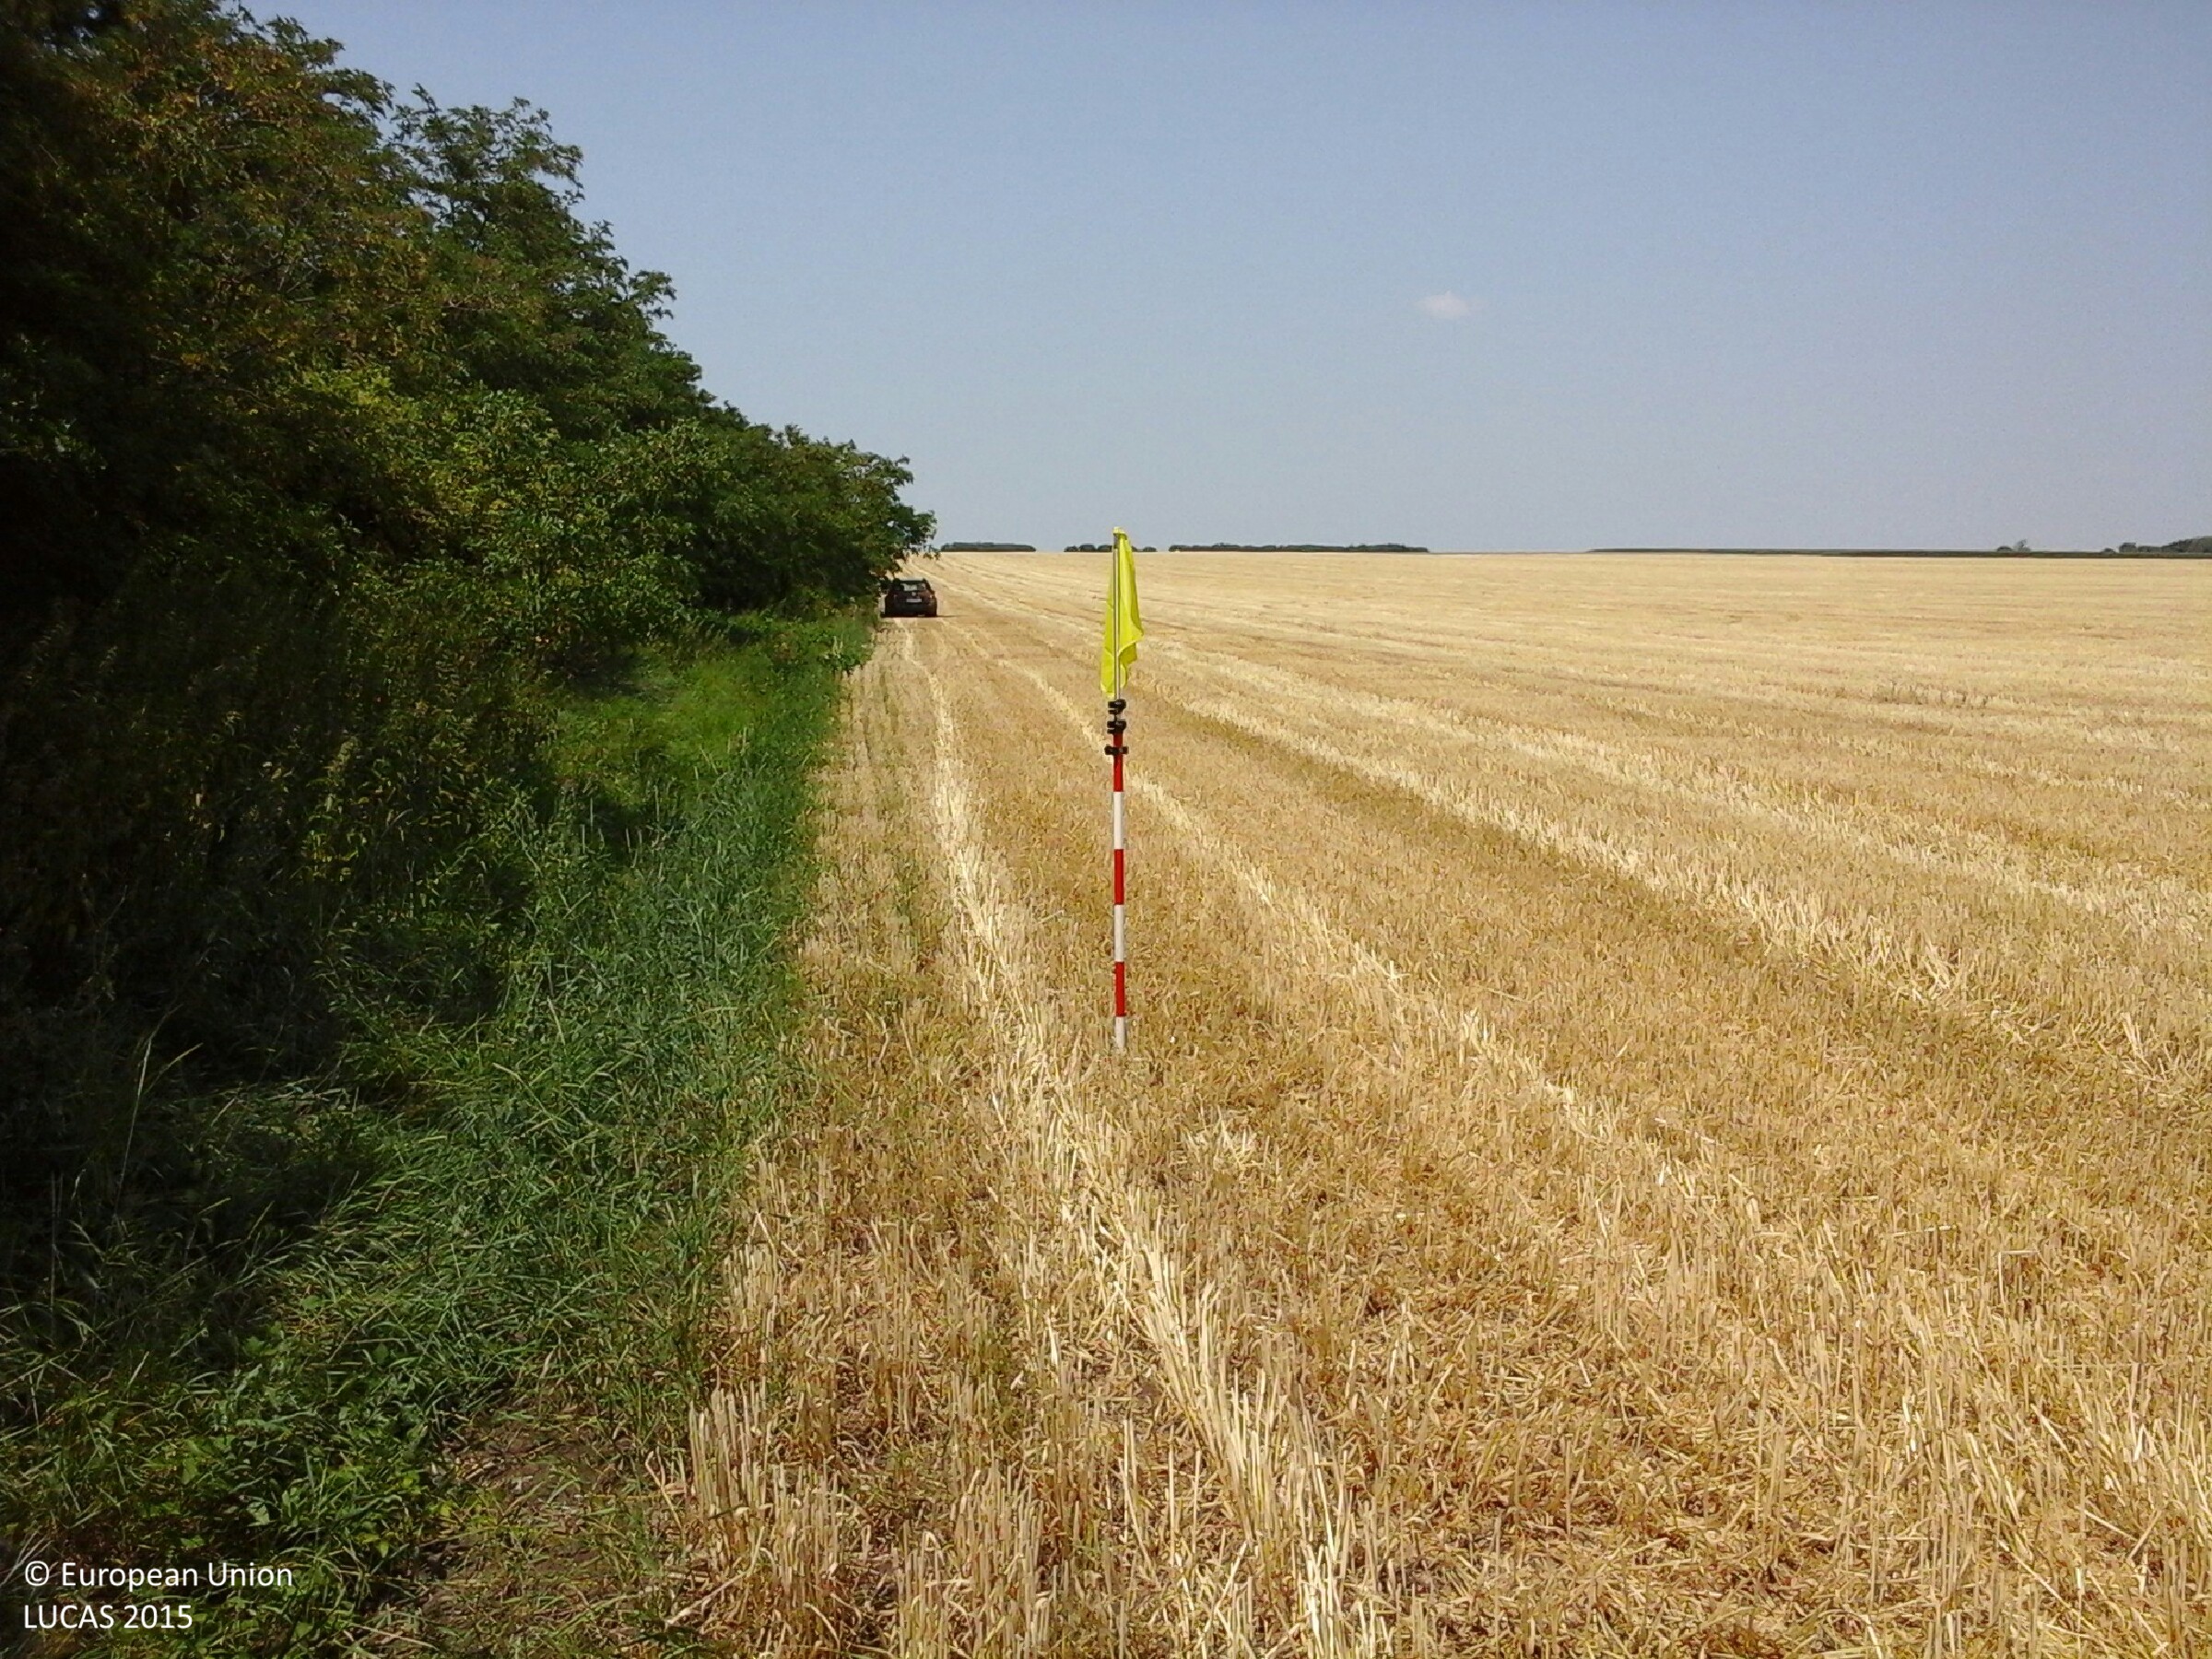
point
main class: Cropland
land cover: Common wheat
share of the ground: > 75 %
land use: Agriculture (excluding fallow land and kitchen gardens)
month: July
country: HU
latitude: 48.0828
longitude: 21.0610
